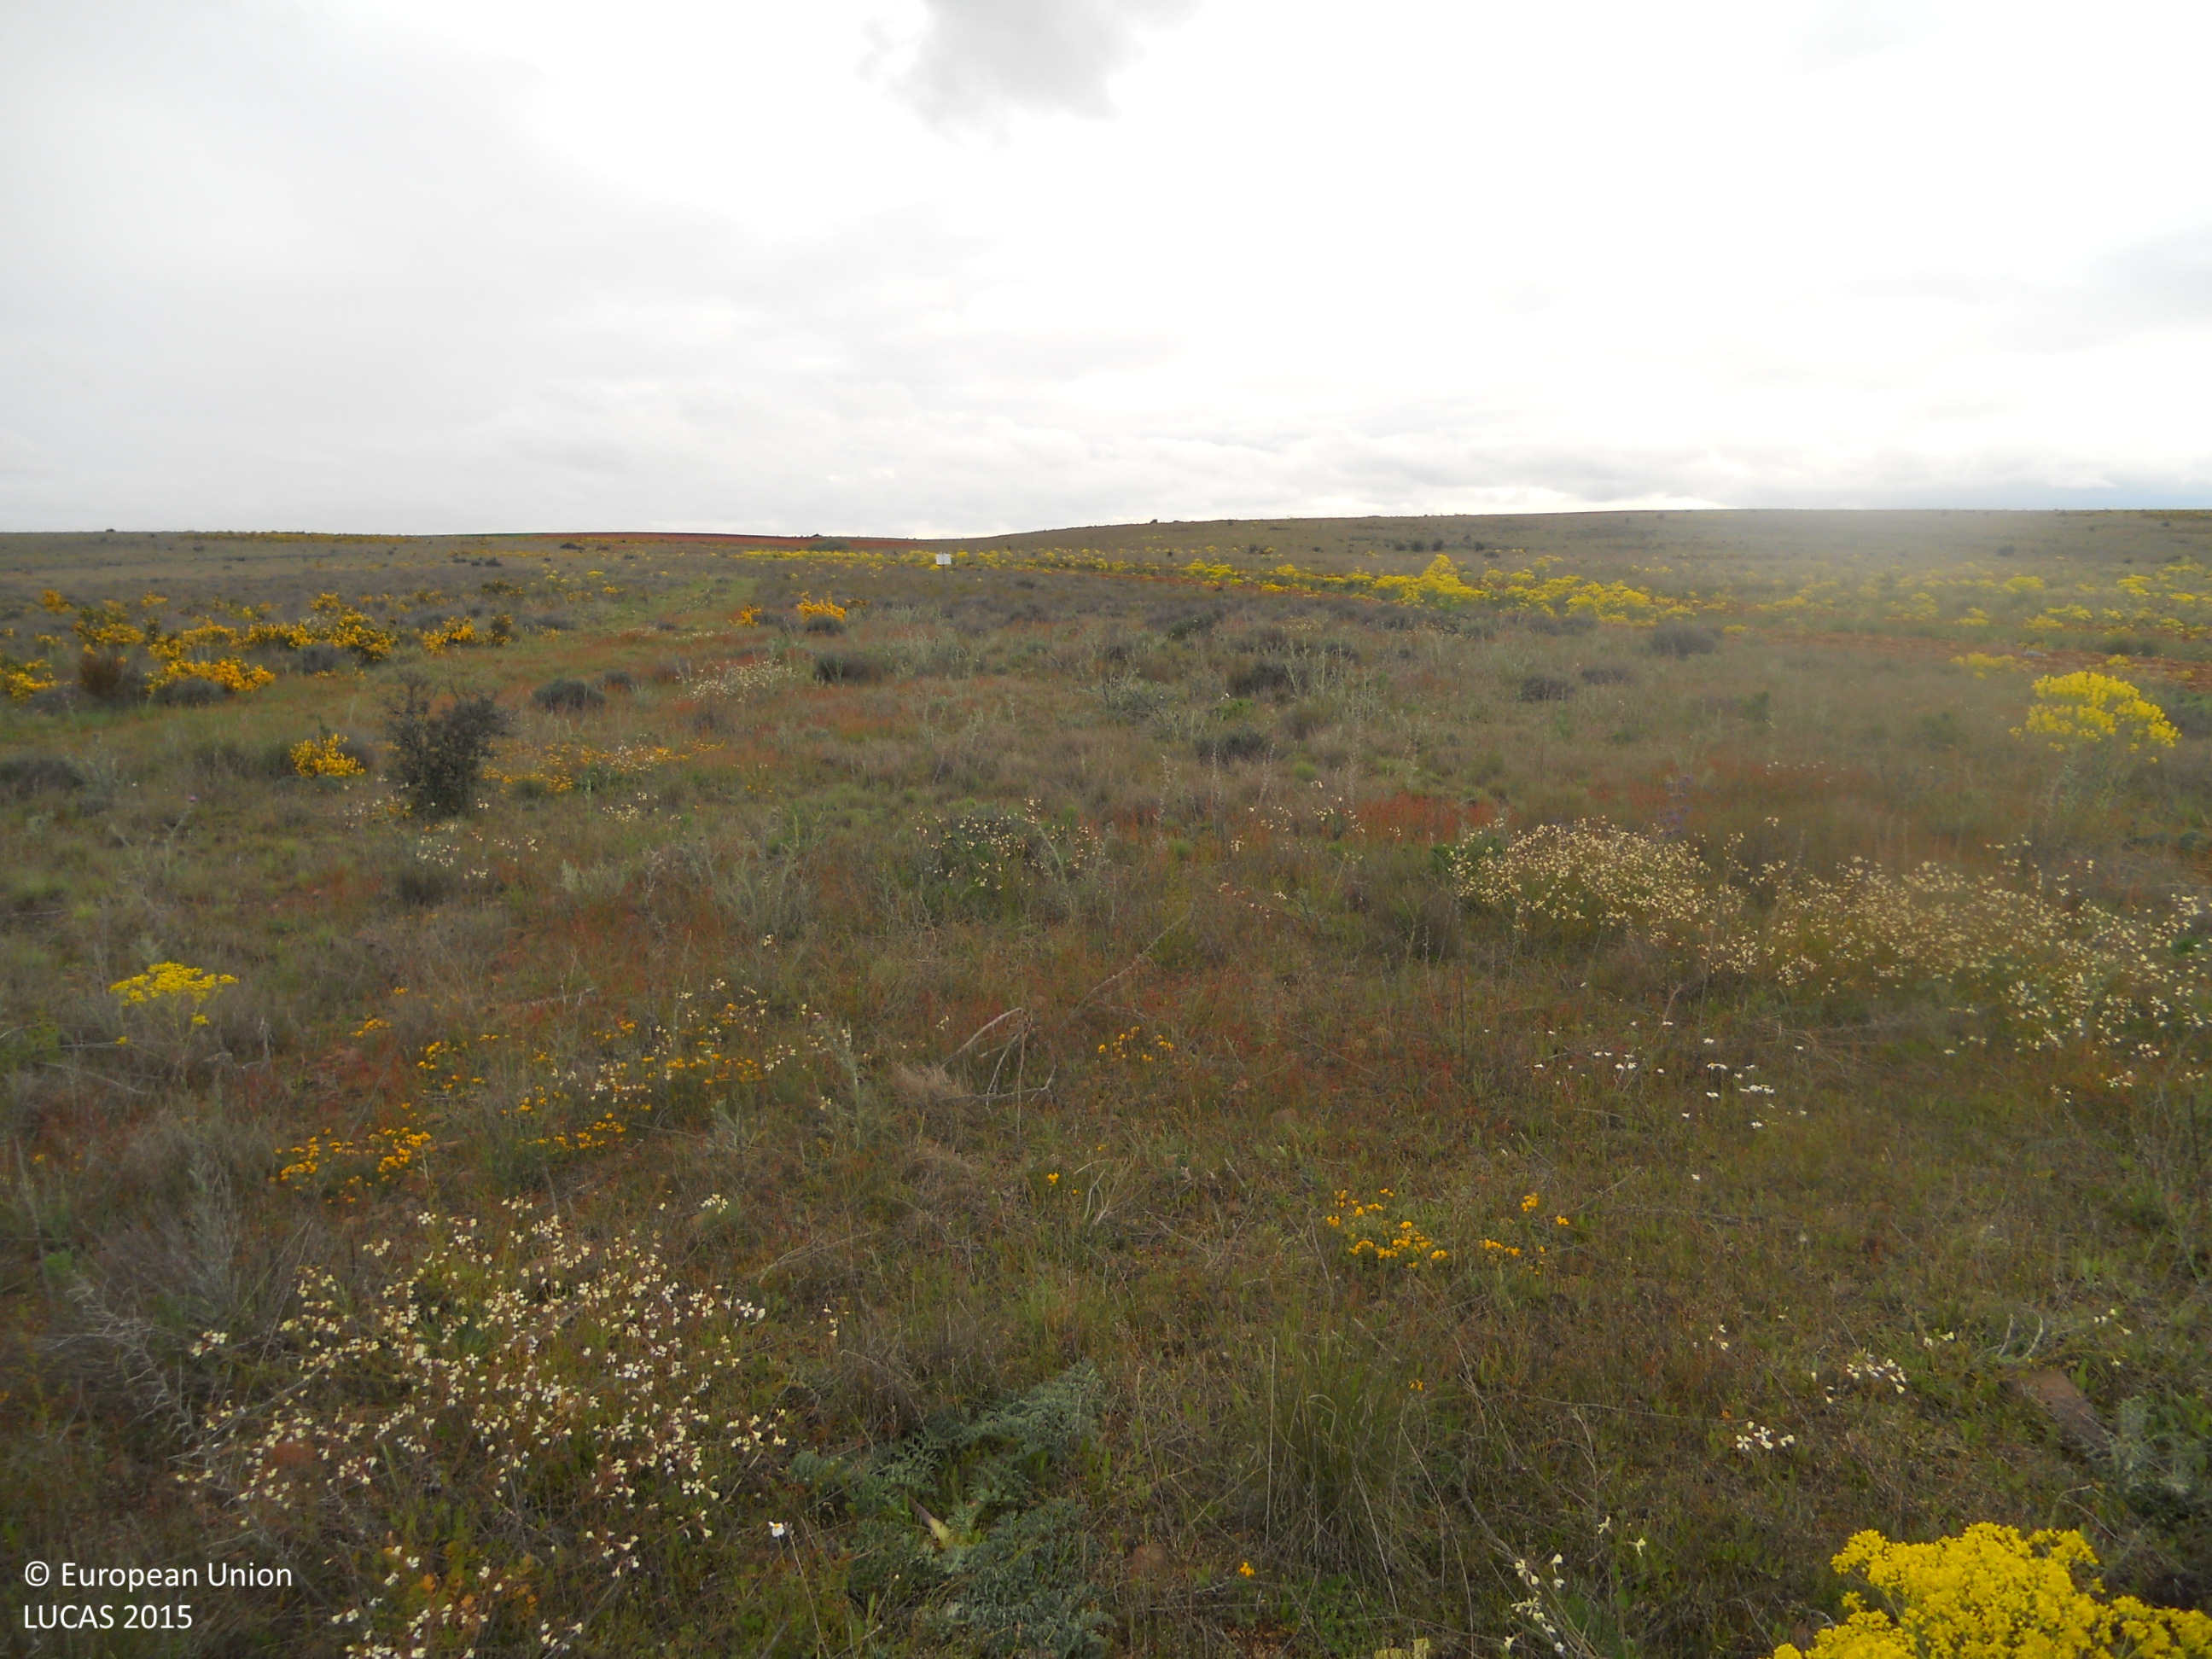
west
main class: Grassland
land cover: Spontaneously vegetated surfaces
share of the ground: > 75 %
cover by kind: herbaceous plants 80 %, unconsolidated bare surface 20 %
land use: Fallow land
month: May
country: ES
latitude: 42.2756
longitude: -5.2802
